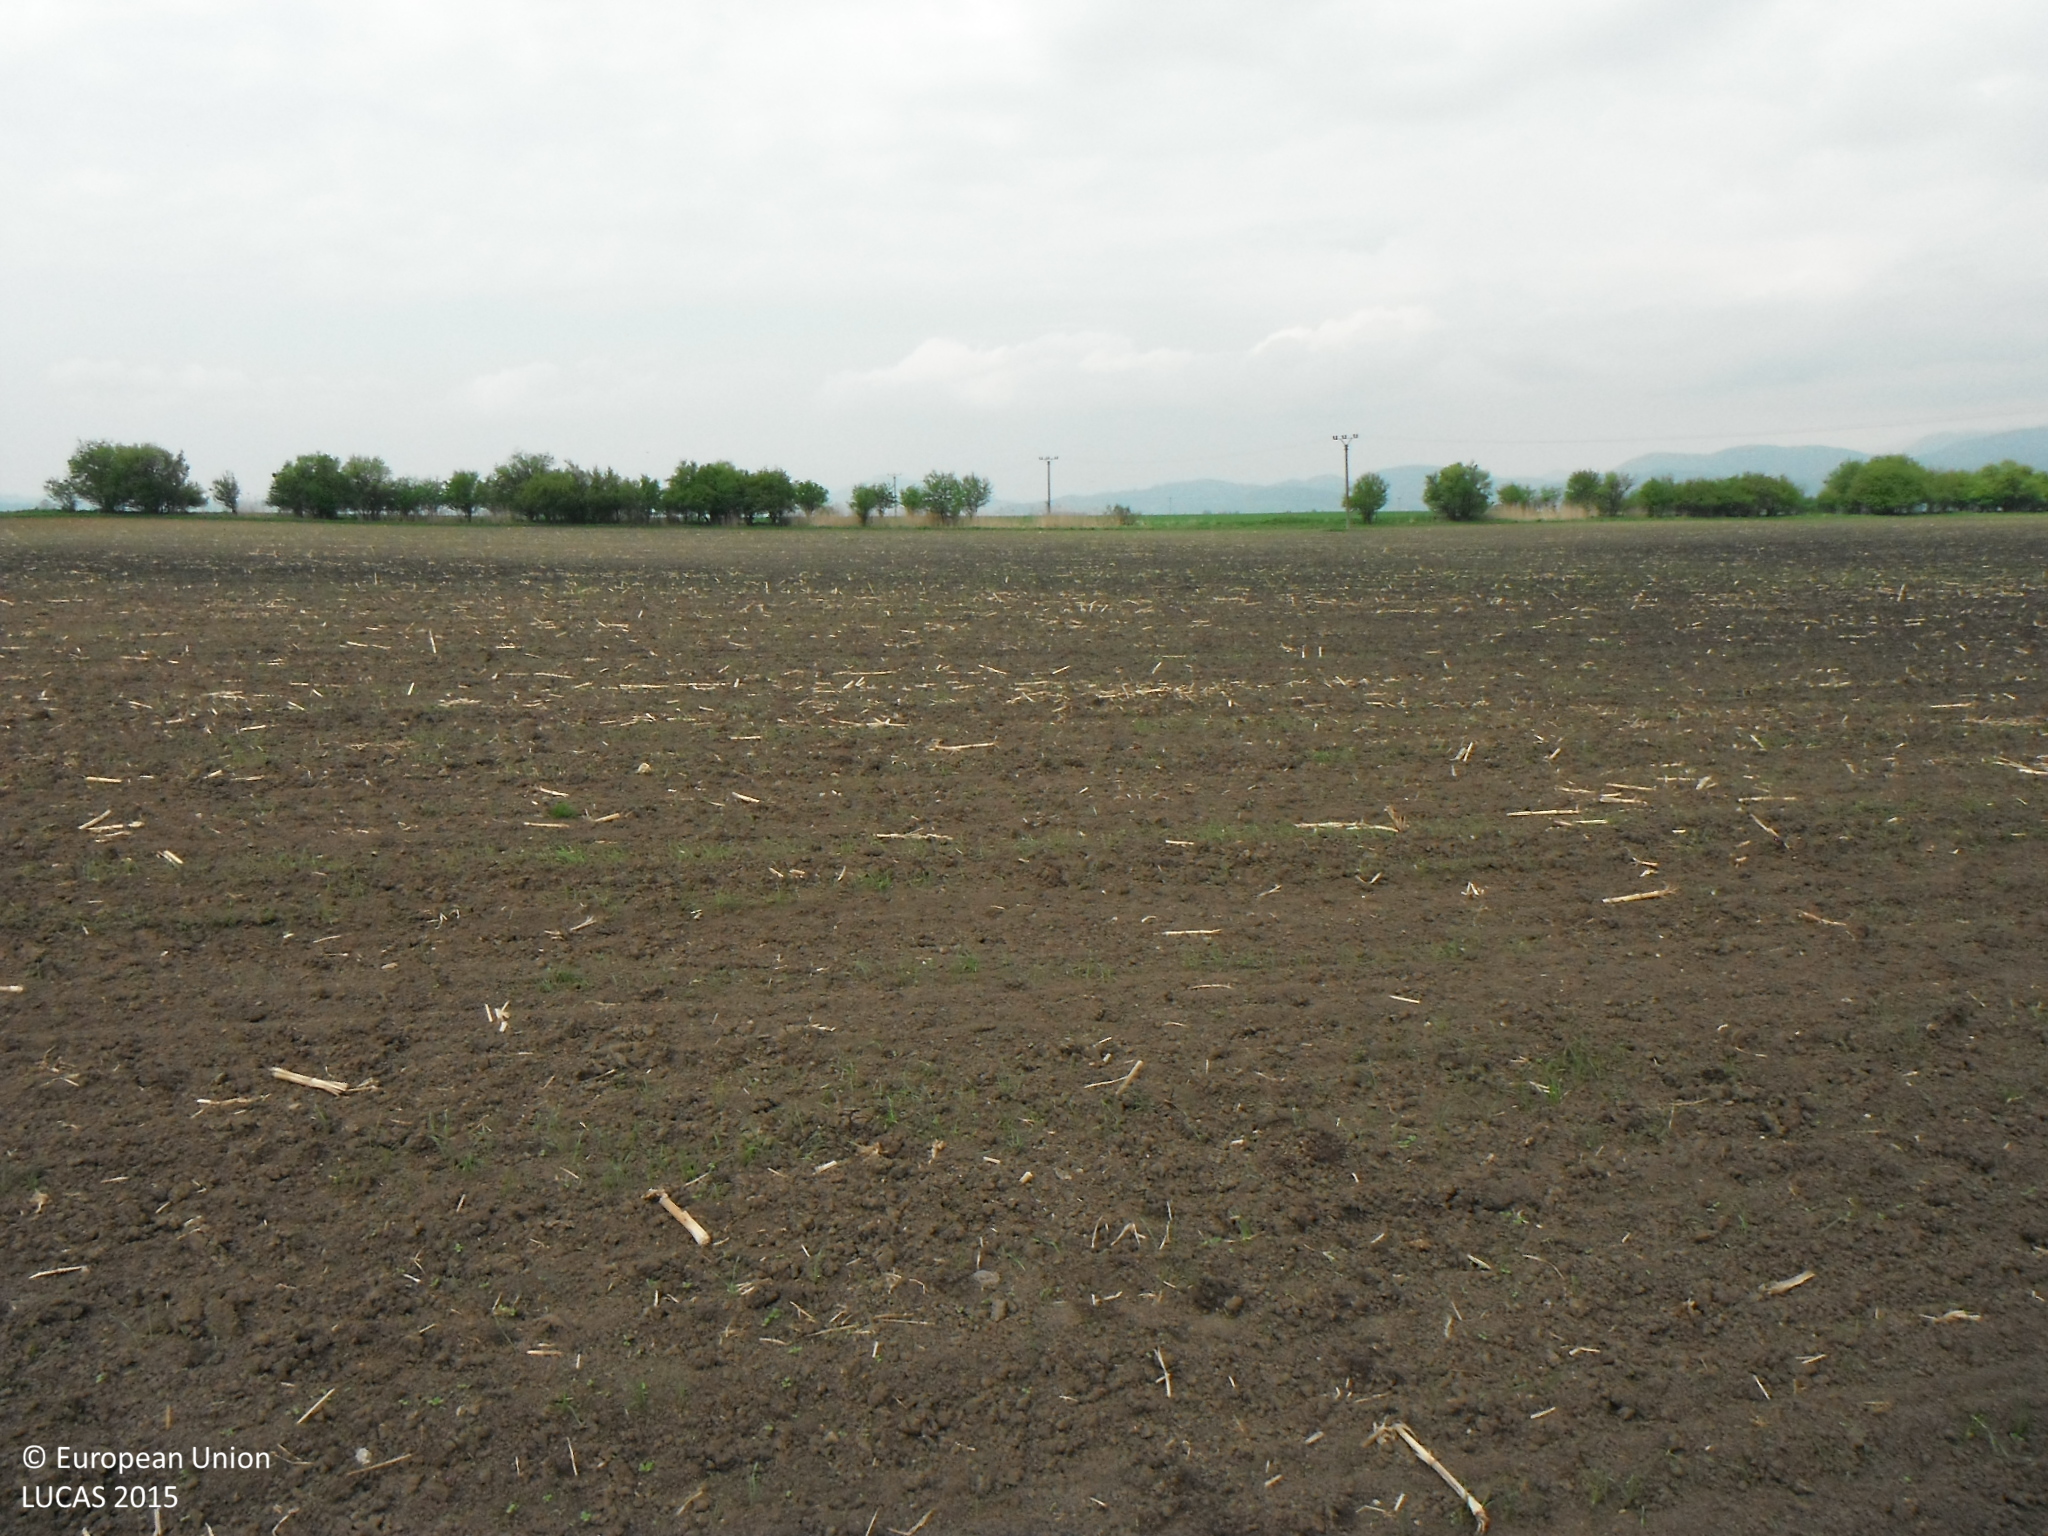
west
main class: Cropland
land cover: Barley
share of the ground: < 10 %
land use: Agriculture (excluding fallow land and kitchen gardens)
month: May
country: SK
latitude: 48.8811
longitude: 18.8429
